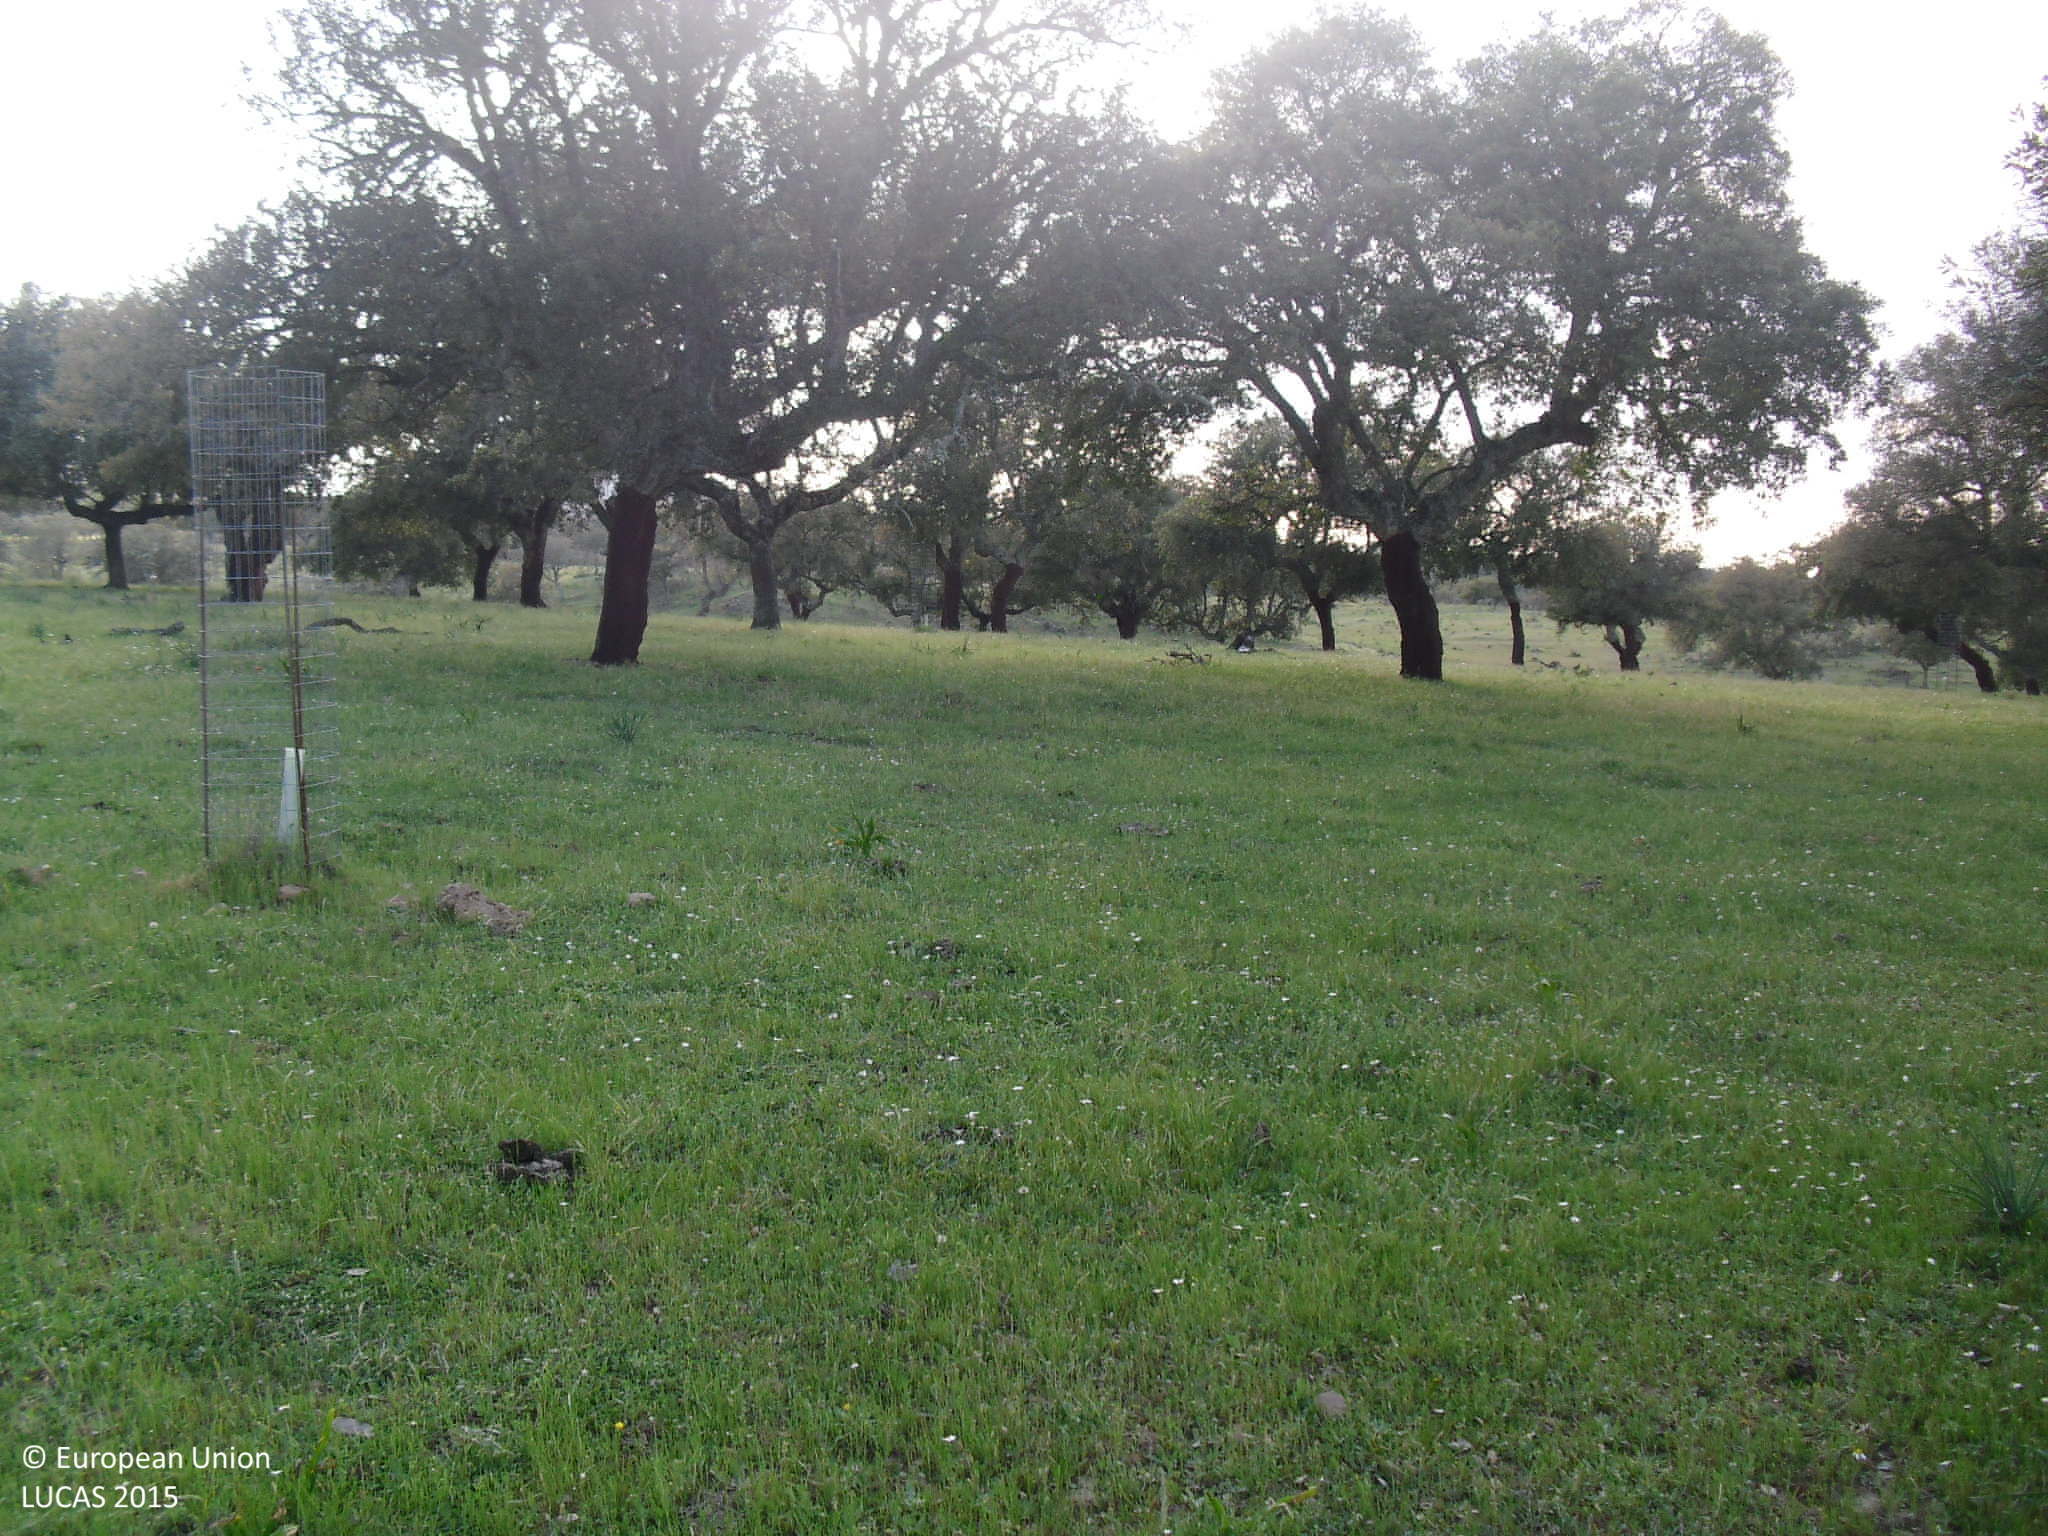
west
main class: Woodland
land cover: Broadleaved woodland
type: broadleaved evergreen forest
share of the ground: > 75 %
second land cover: Grassland without tree/shrub cover
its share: > 75 %
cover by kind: herbaceous plants 85 %, broadleaved forest trees 15 %
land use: Forestry
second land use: Agriculture (excluding fallow land and kitchen gardens)
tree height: > 5 m
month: April
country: ES
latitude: 39.3821
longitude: -6.5673
